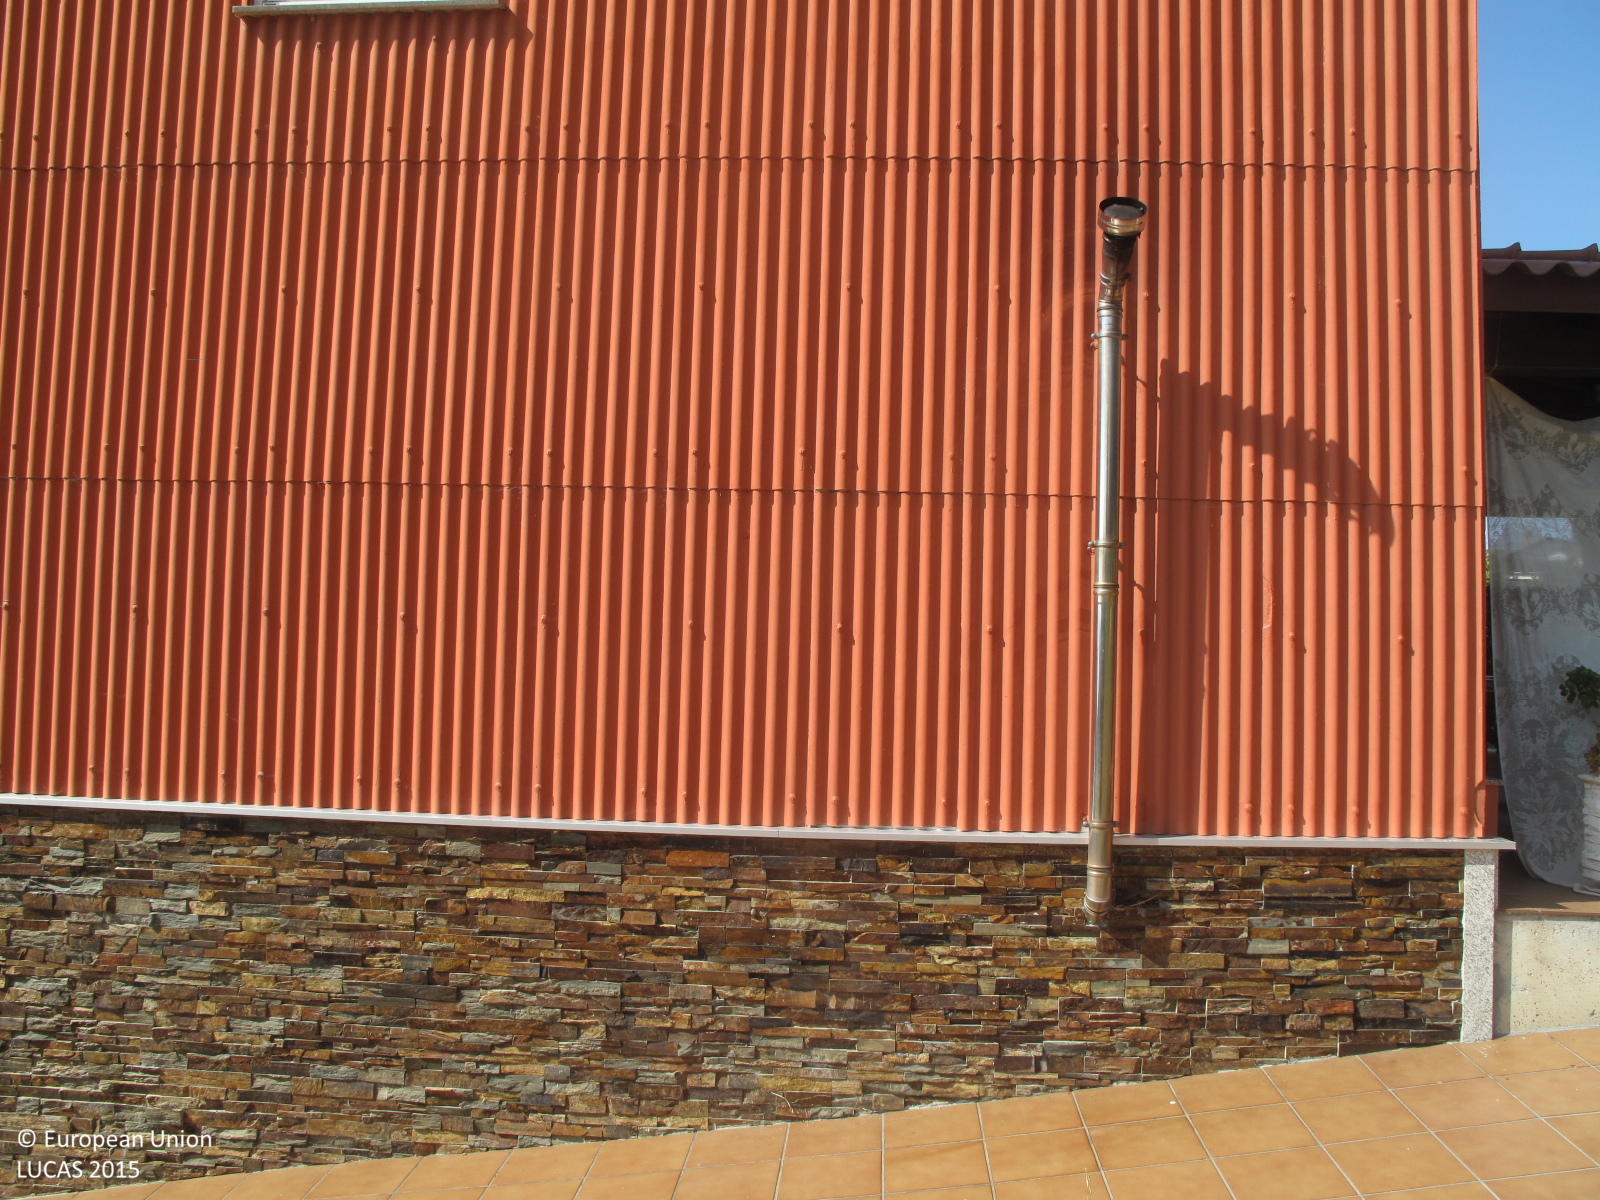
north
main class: Grassland
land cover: Grassland without tree/shrub cover
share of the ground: > 75 %
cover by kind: herbaceous plants 90 %, shrubs 5 %, unconsolidated bare surface 5 %
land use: Agriculture (excluding fallow land and kitchen gardens)
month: July
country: ES
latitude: 43.4653
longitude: -8.1845
